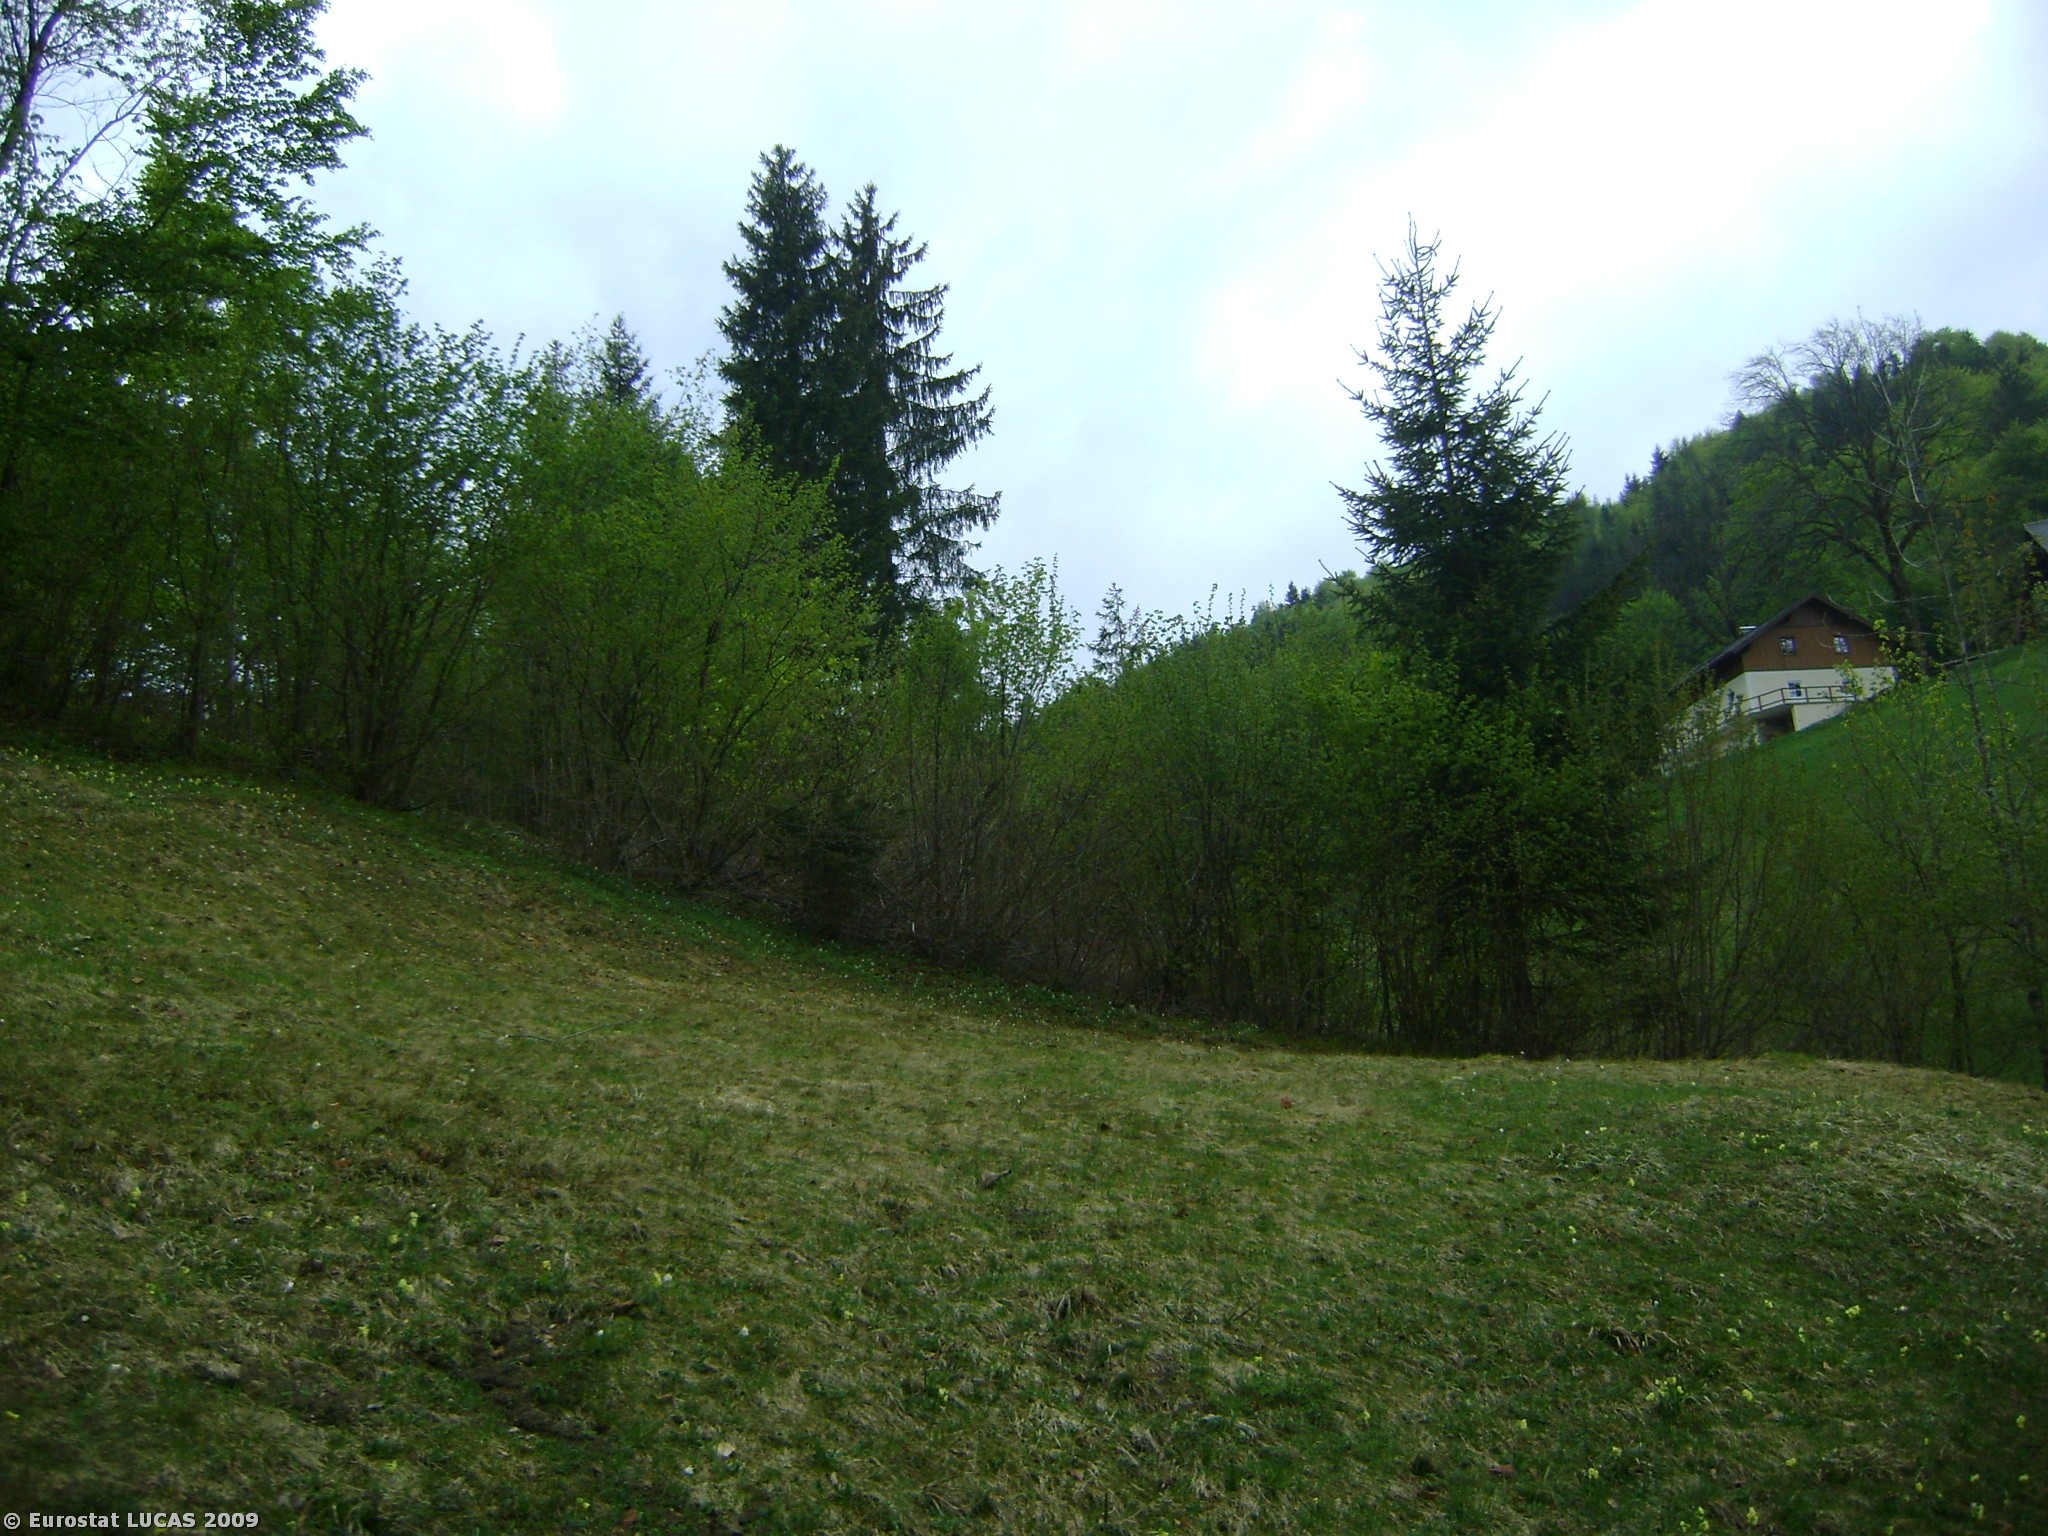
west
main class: Grassland
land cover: Grassland without tree/shrub cover
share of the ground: > 75 %
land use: Agriculture (excluding fallow land and kitchen gardens)
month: May
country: AT
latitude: 47.7625
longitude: 13.2140
